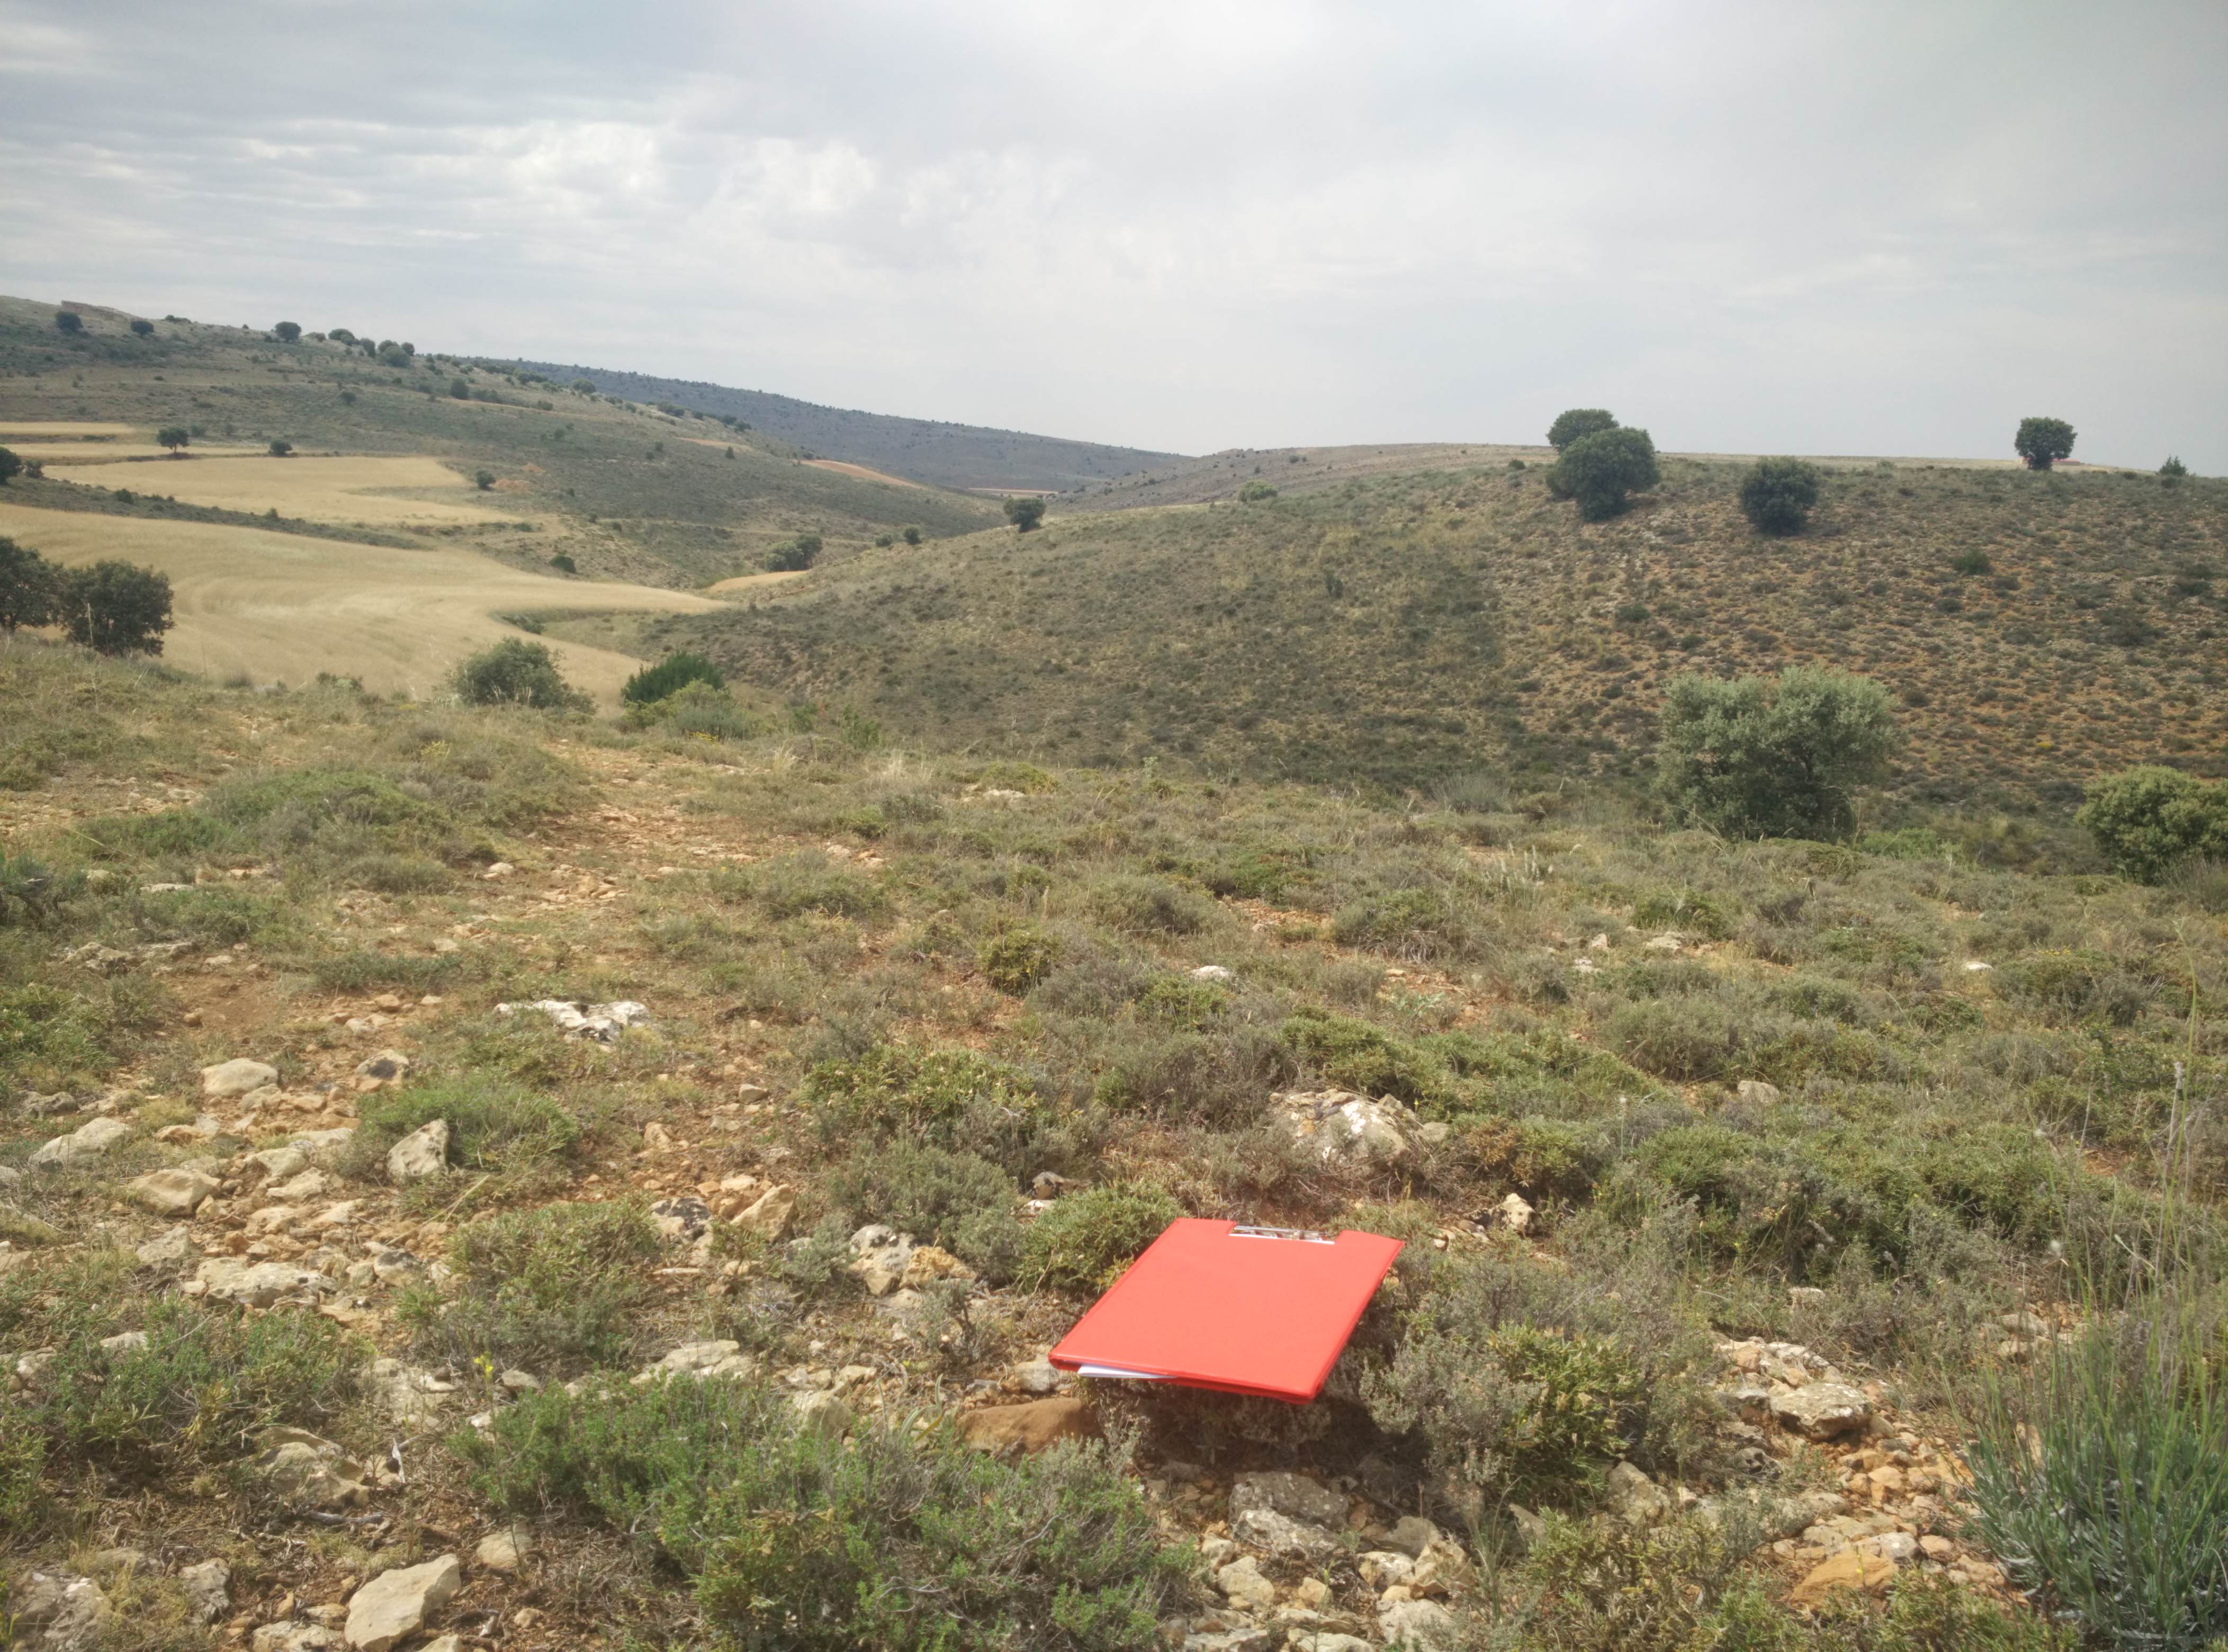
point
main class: Shrubland
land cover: Shrubland without tree cover
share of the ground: > 75 %
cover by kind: shrubs 80 %, unconsolidated bare surface 20 %
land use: Semi-natural and natural areas not in use
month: July
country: ES
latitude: 41.0602
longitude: -1.8641
